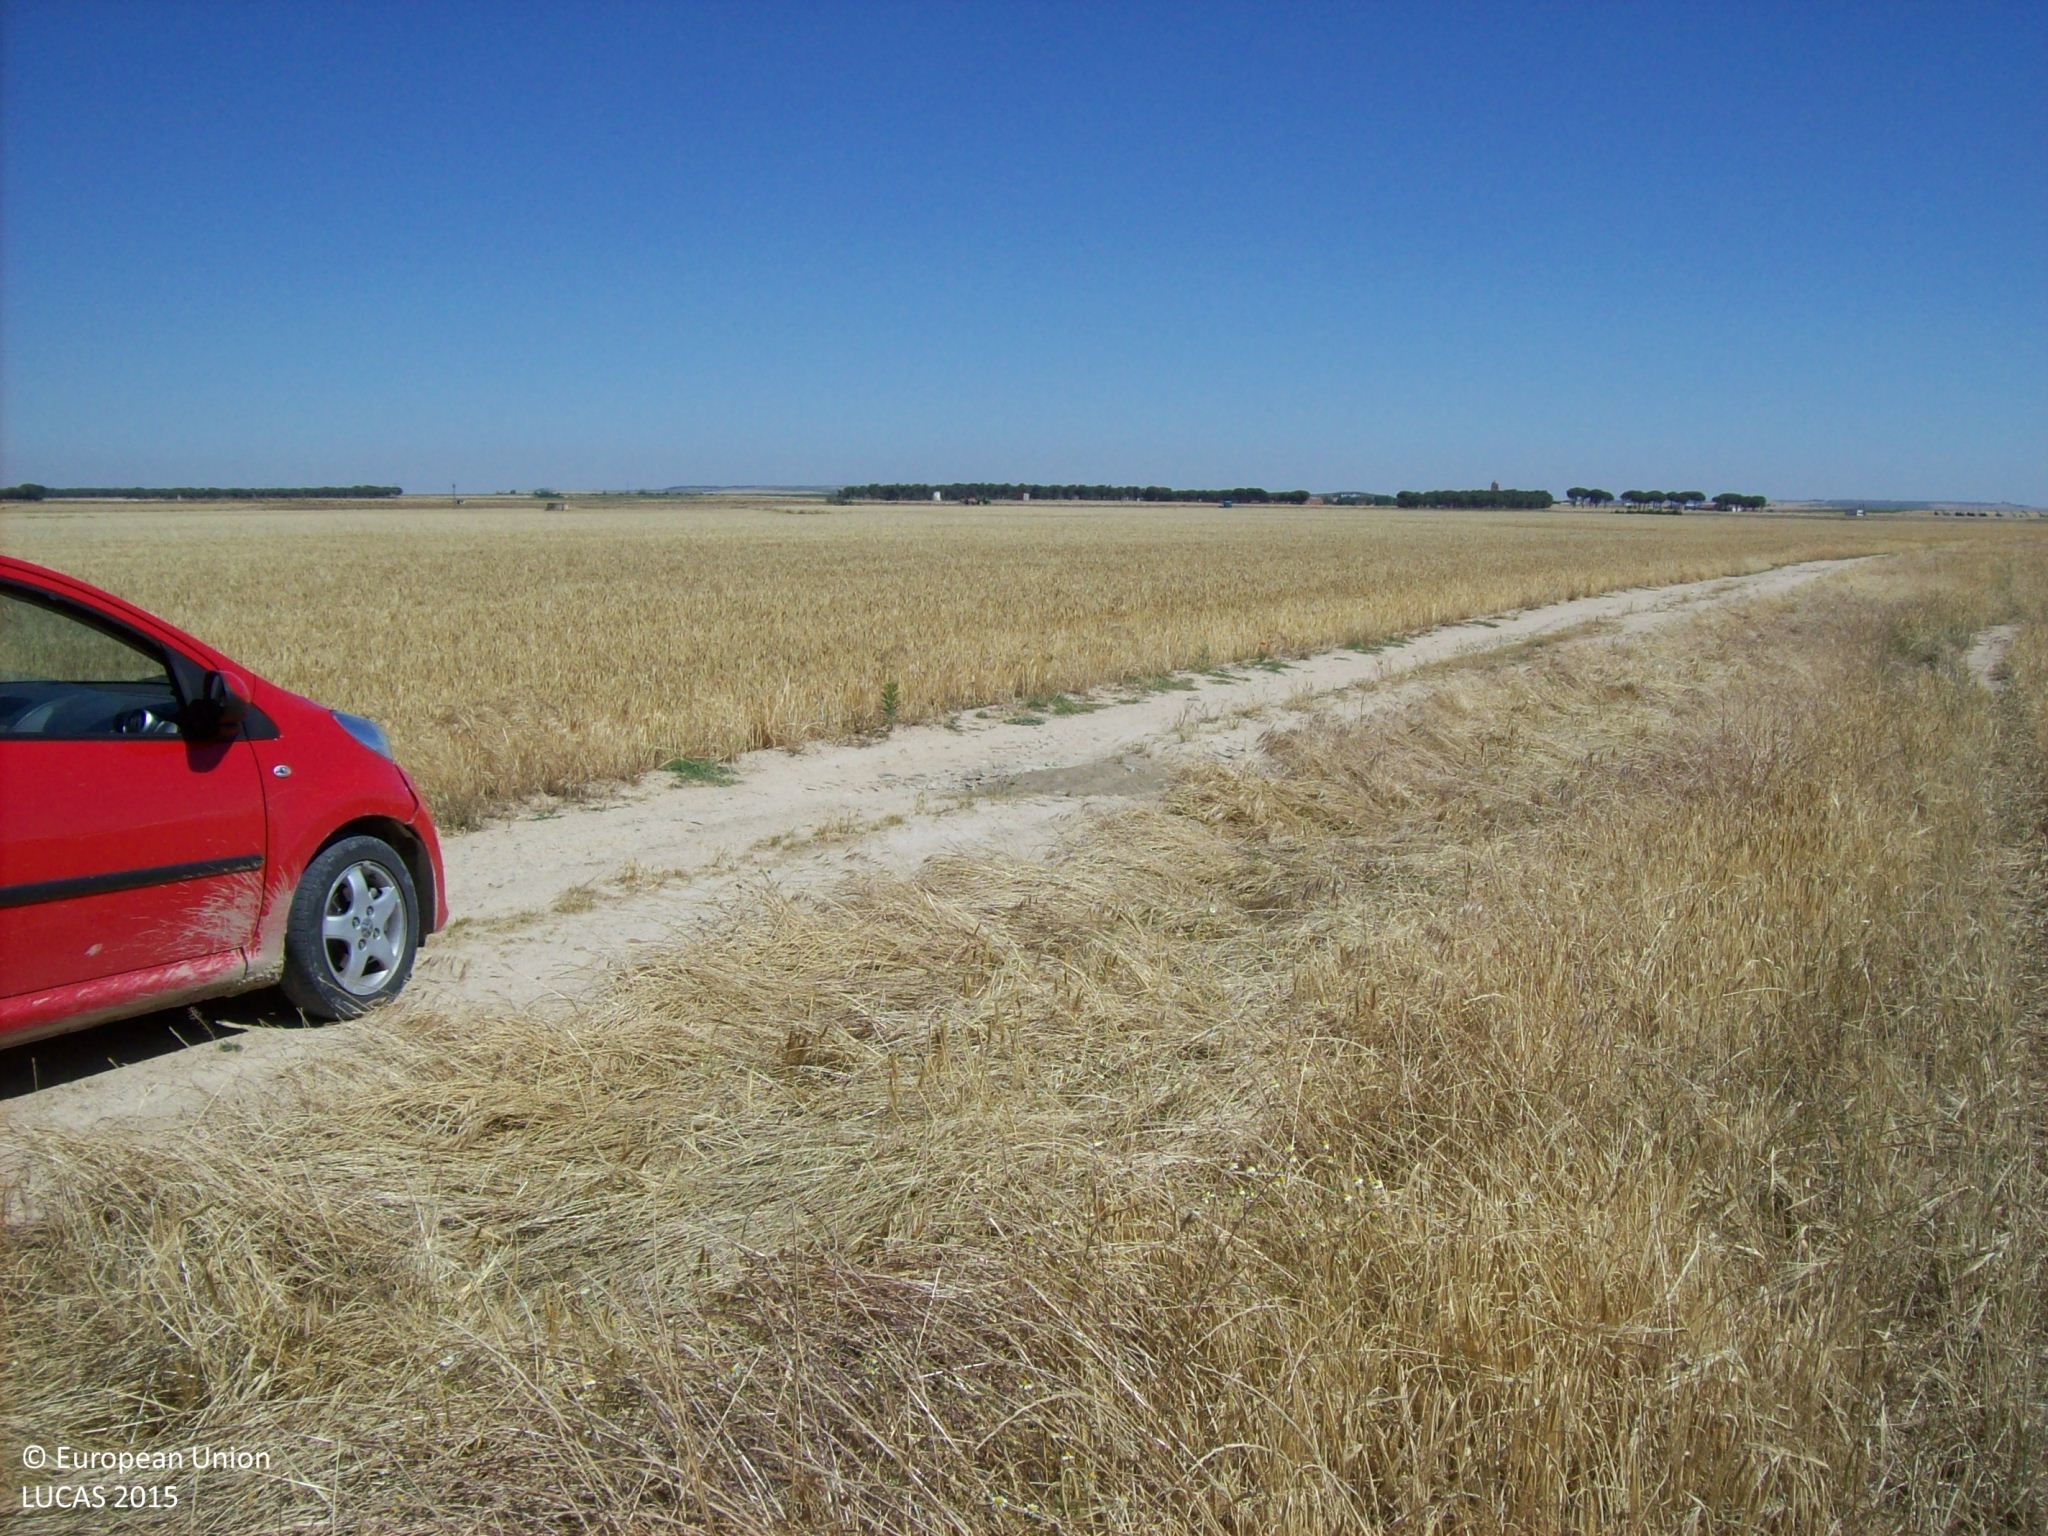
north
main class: Cropland
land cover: Barley
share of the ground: > 75 %
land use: Agriculture (excluding fallow land and kitchen gardens)
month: June
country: ES
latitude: 41.2335
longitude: -5.0180
